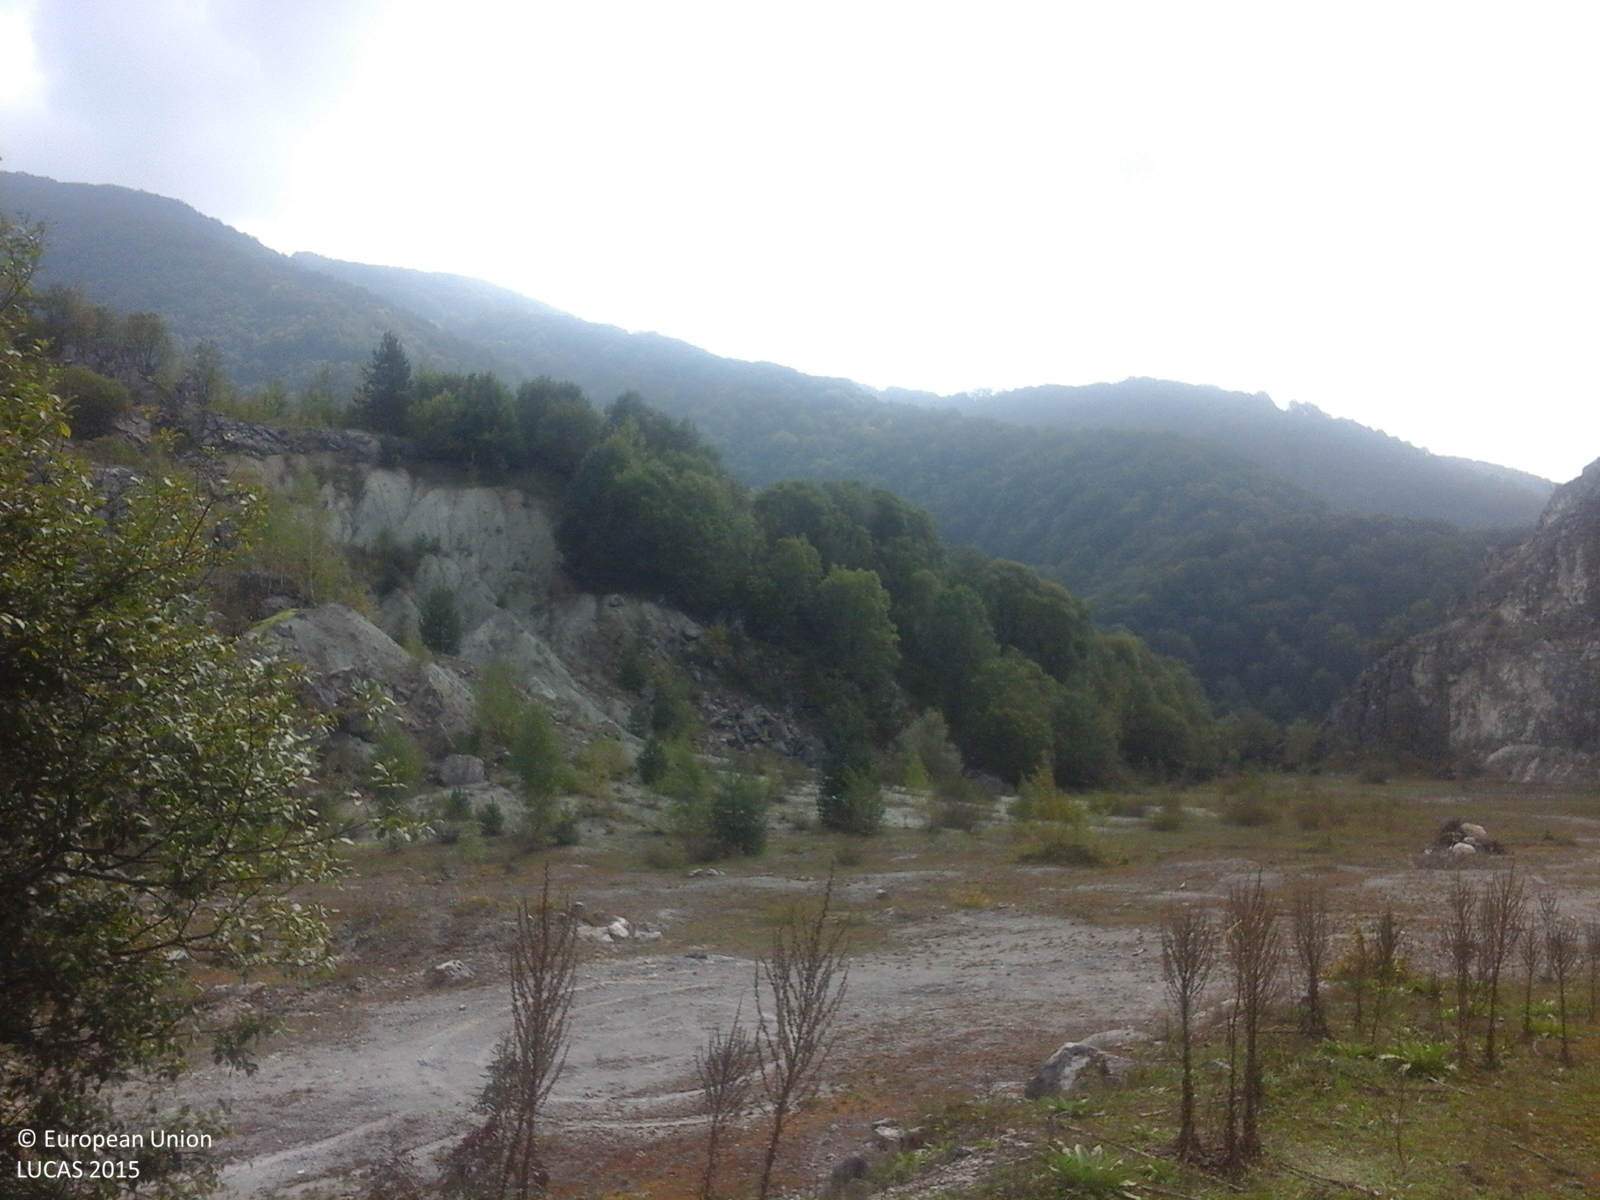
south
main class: Grassland
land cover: Spontaneously vegetated surfaces
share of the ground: > 75 %
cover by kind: herbaceous plants 100 %
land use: Semi-natural and natural areas not in use
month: September
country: RO
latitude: 45.1352
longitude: 22.6980
